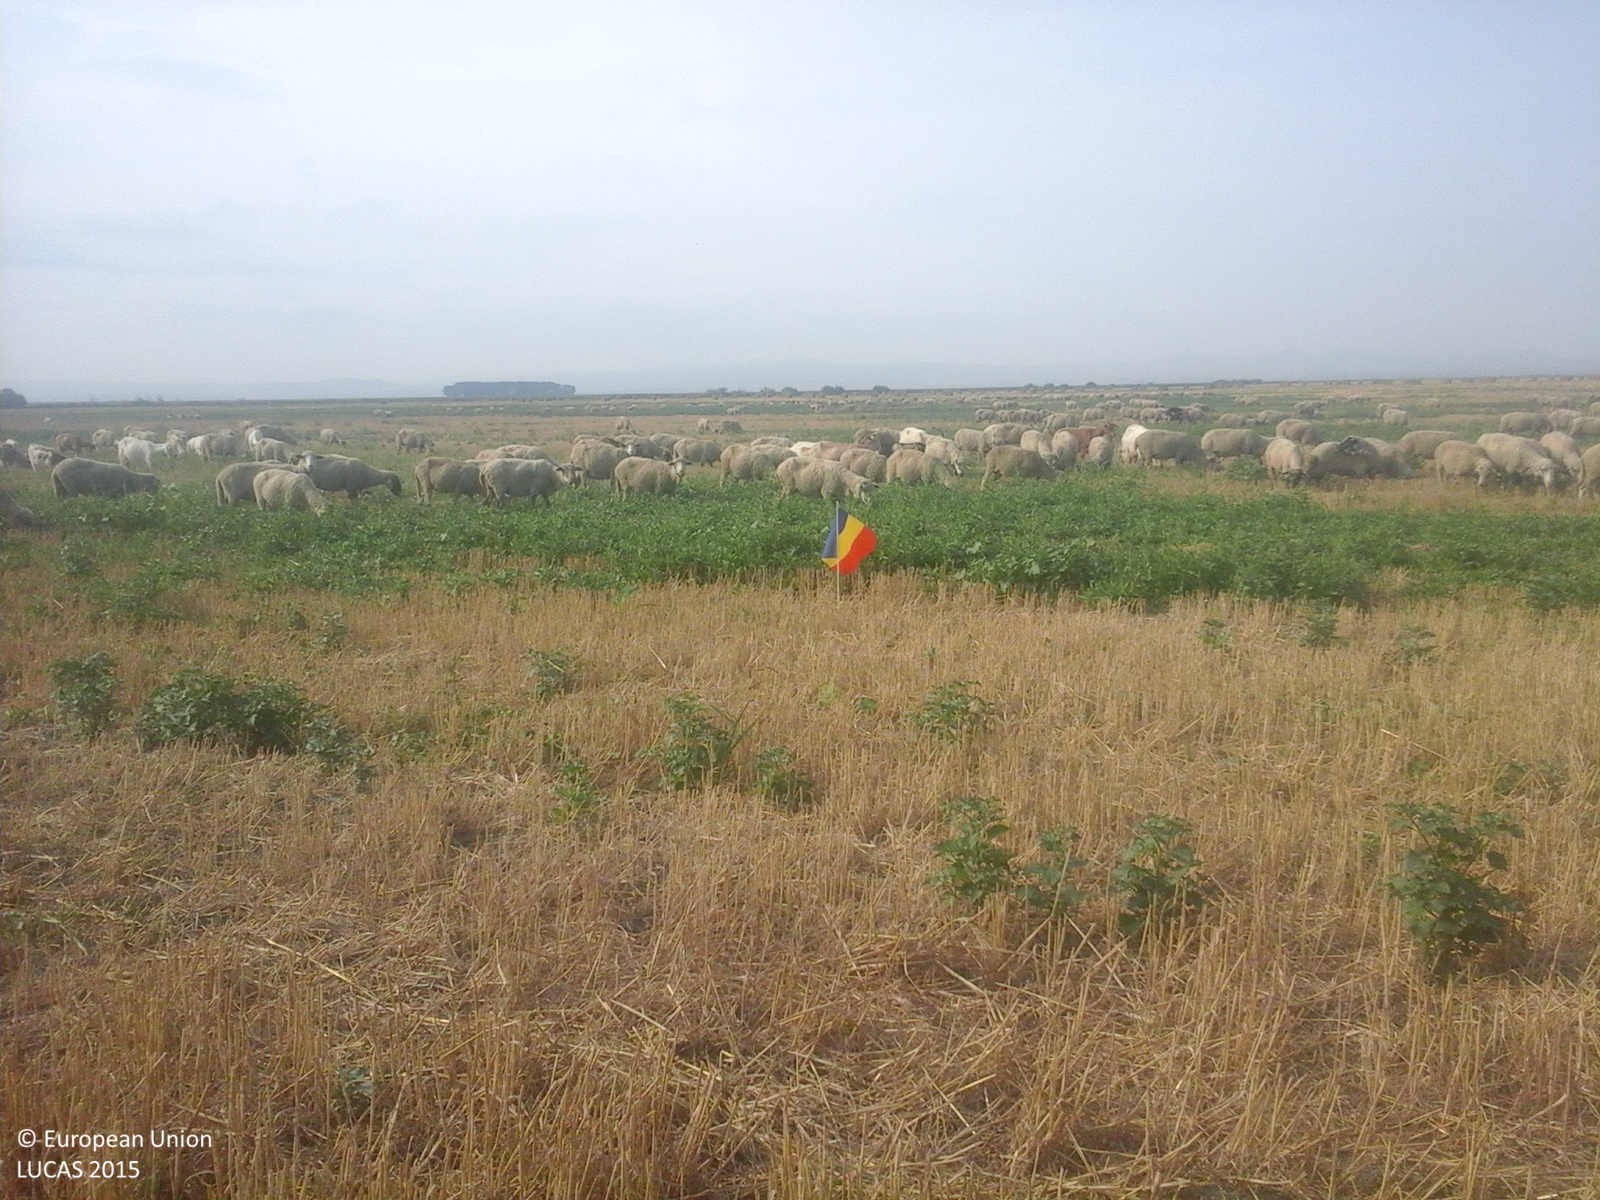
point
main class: Cropland
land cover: Durum wheat
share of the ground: > 75 %
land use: Agriculture (excluding fallow land and kitchen gardens)
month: July
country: RO
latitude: 45.3911
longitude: 28.2496
